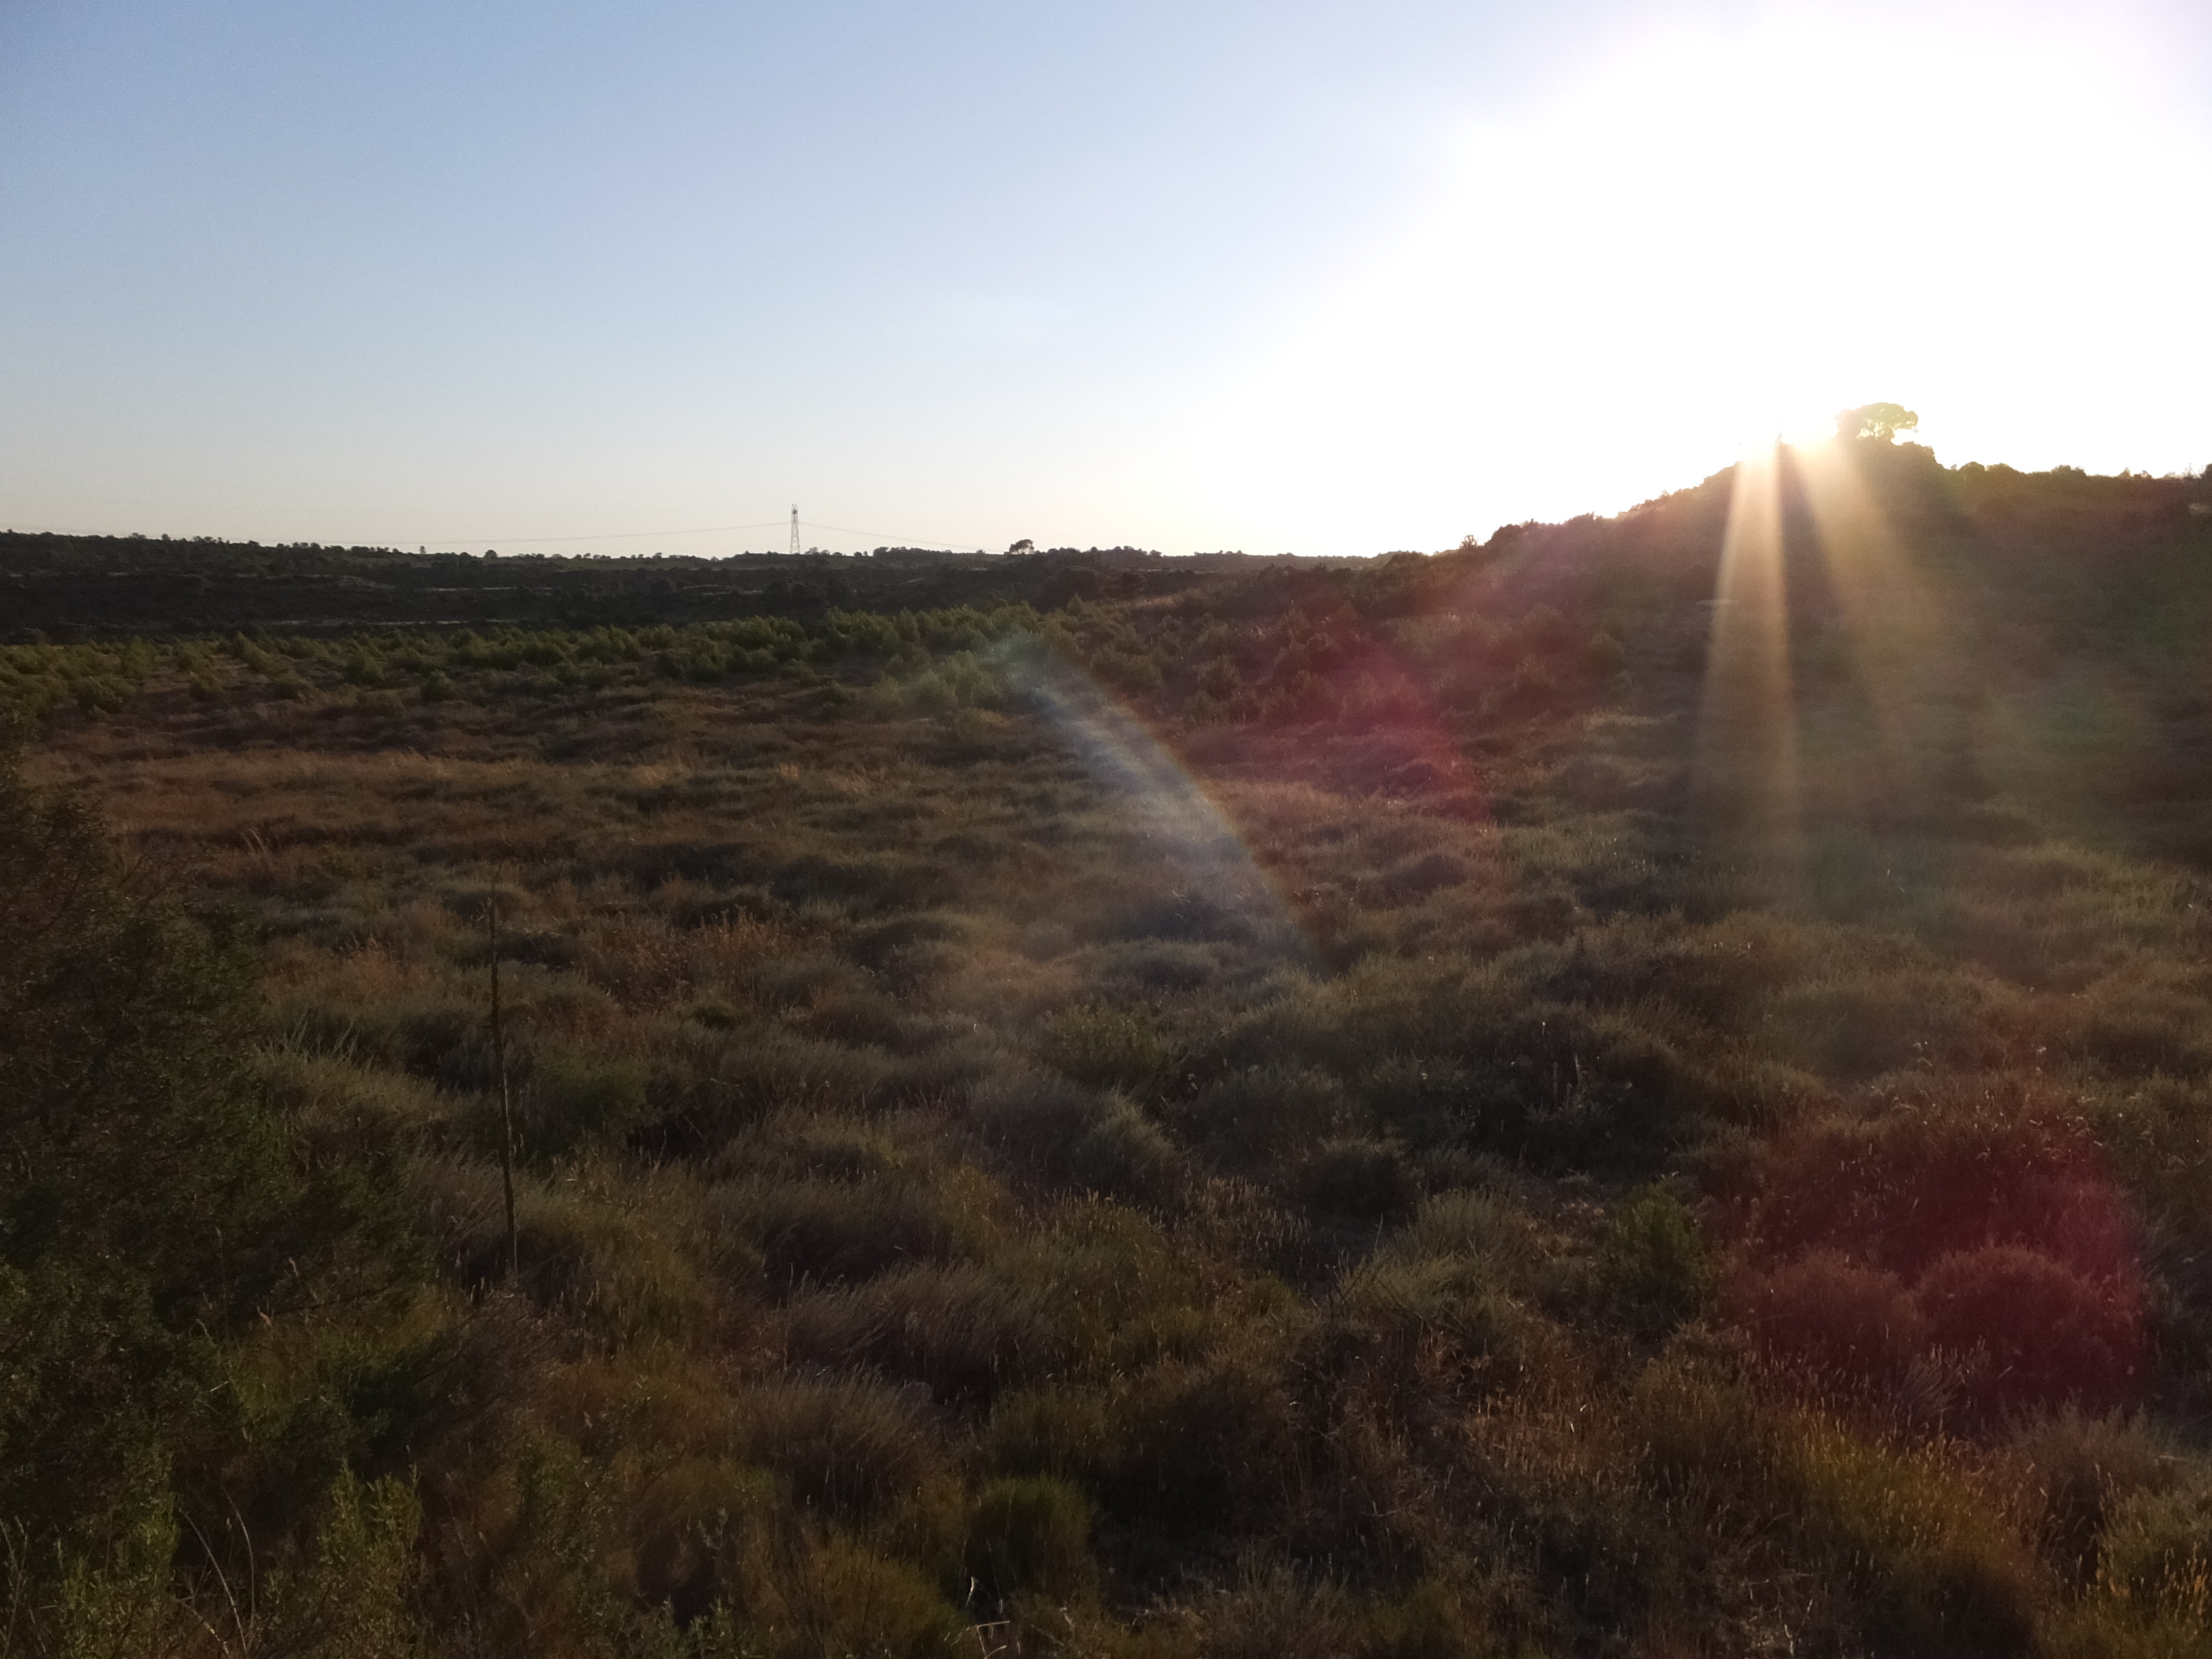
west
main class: Shrubland
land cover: Shrubland with sparse tree cover
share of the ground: > 75 %
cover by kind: shrubs 75 %, herbaceous plants 20 %, coniferous forest trees 5 %
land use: Semi-natural and natural areas not in use
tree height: < 5 m
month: June
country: ES
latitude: 41.3087
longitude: -0.2988
